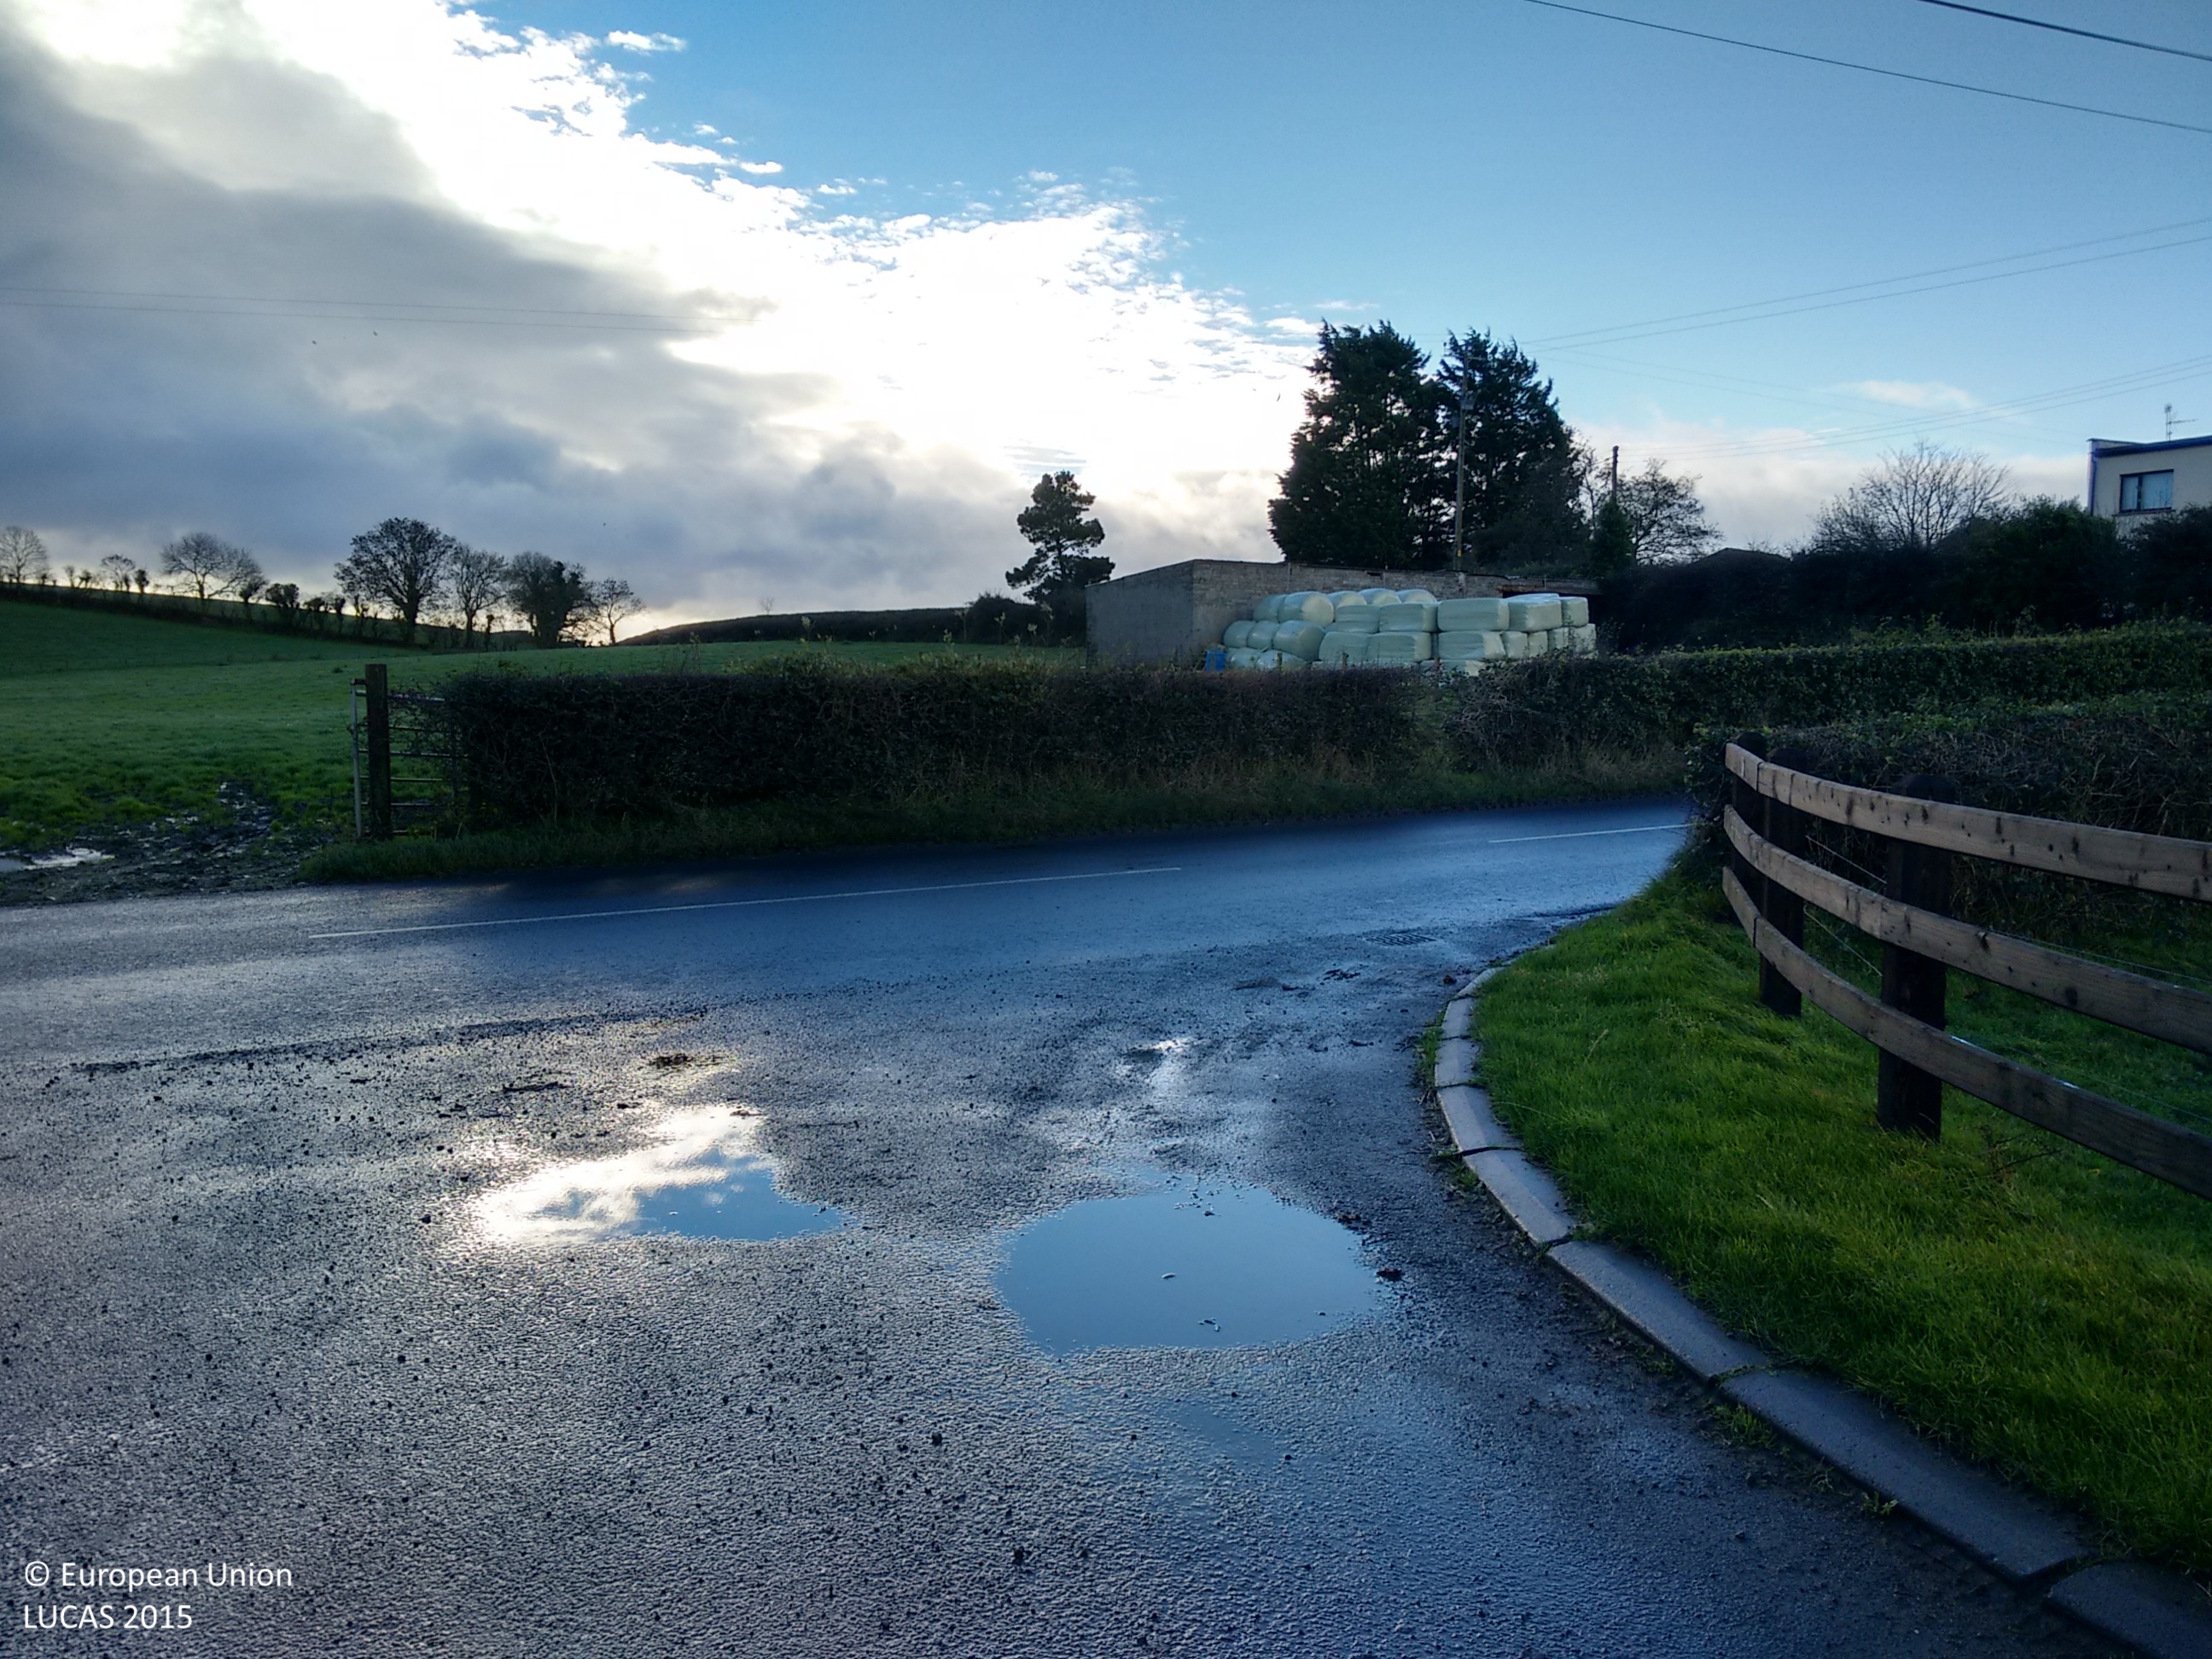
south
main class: Grassland
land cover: Grassland without tree/shrub cover
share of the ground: > 75 %
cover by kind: herbaceous plants 100 %
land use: Agriculture (excluding fallow land and kitchen gardens)
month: November
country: GB
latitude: 54.5842
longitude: -5.5873
